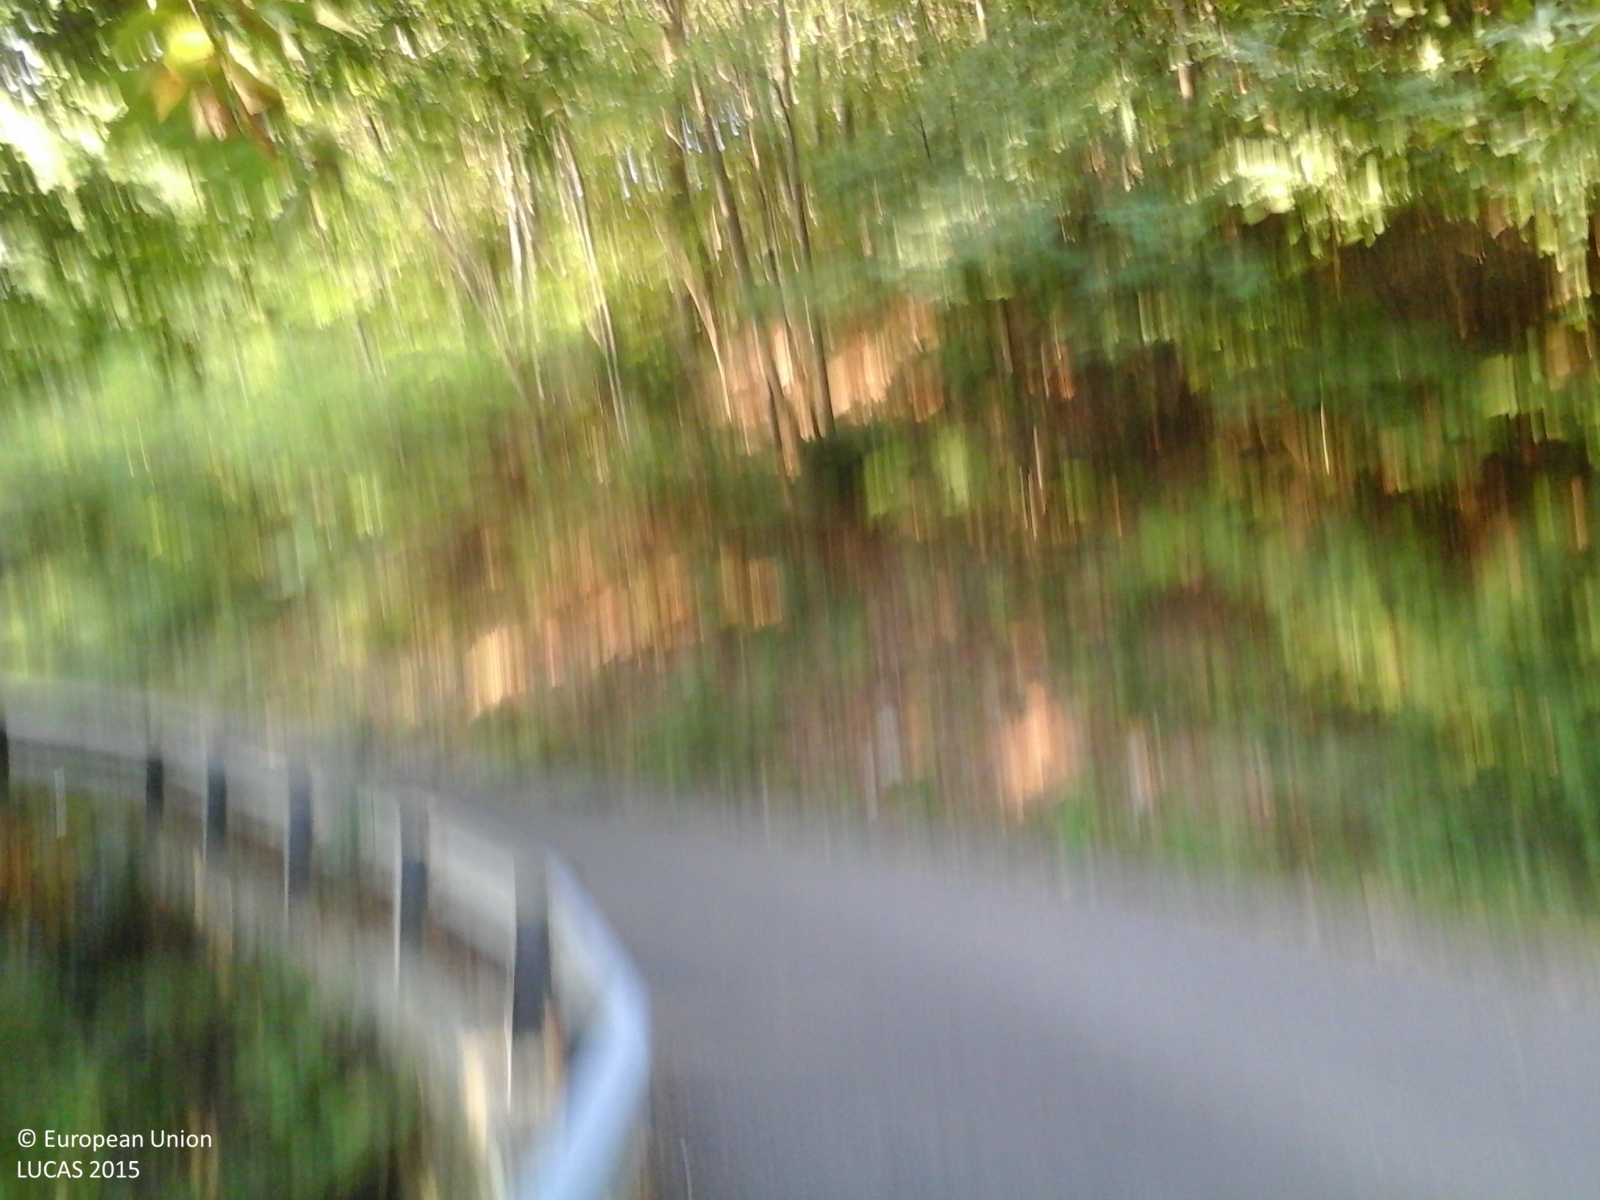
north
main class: Woodland
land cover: Broadleaved woodland
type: thermophilous deciduous forest
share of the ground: > 75 %
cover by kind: broadleaved forest trees 100 %
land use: Semi-natural and natural areas not in use
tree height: > 5 m
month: September
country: IT
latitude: 44.3184
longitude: 8.2861
